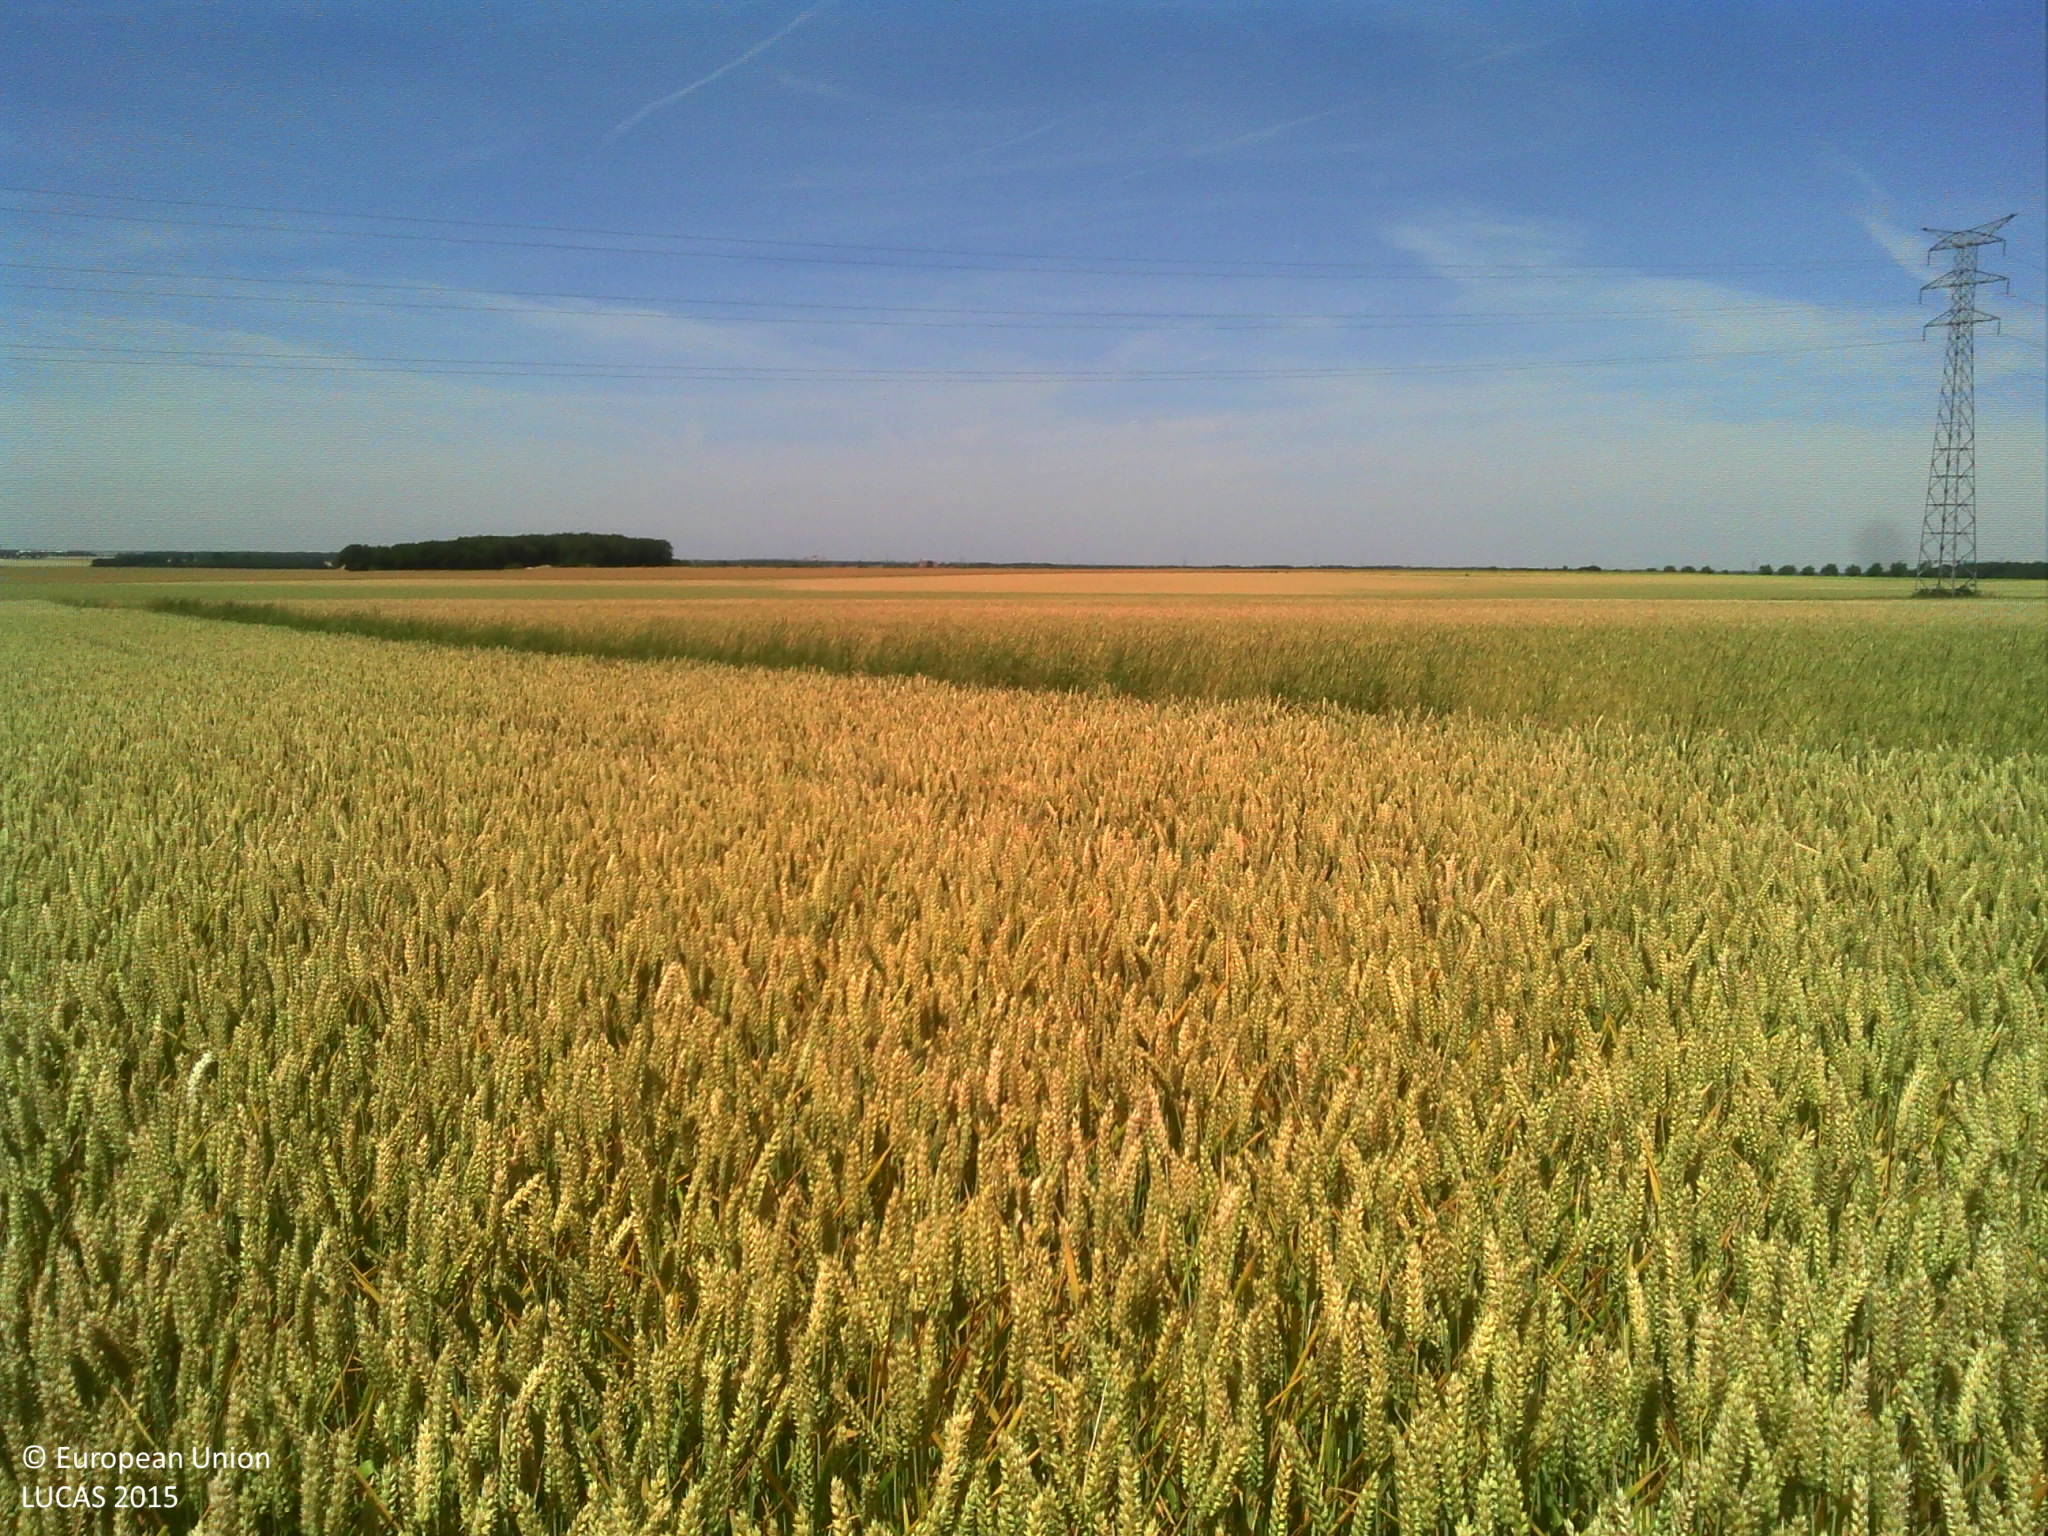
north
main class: Cropland
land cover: Common wheat
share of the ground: > 75 %
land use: Agriculture (excluding fallow land and kitchen gardens)
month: June
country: FR
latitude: 48.6462
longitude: 1.3905
